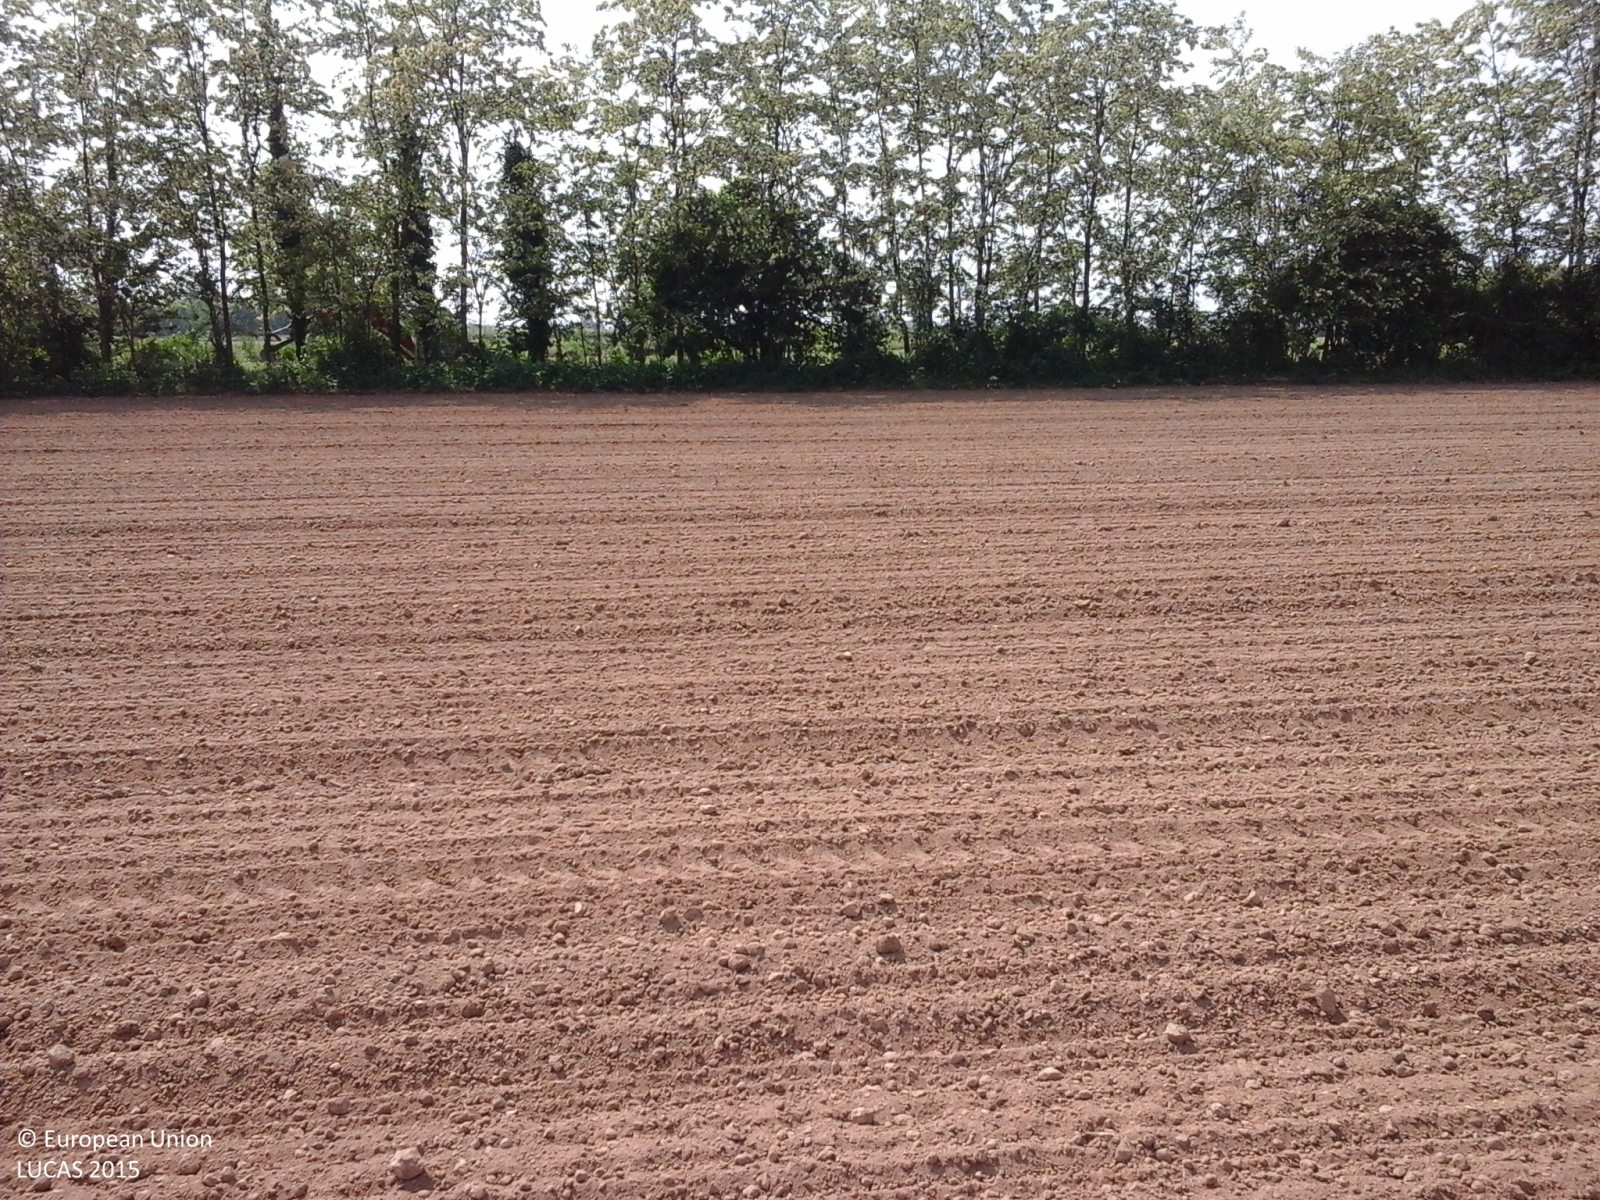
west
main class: Cropland
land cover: Soya
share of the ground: < 10 %
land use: Agriculture (excluding fallow land and kitchen gardens)
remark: Tilled/Sowed
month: May
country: IT
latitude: 45.1799
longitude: 9.8603
